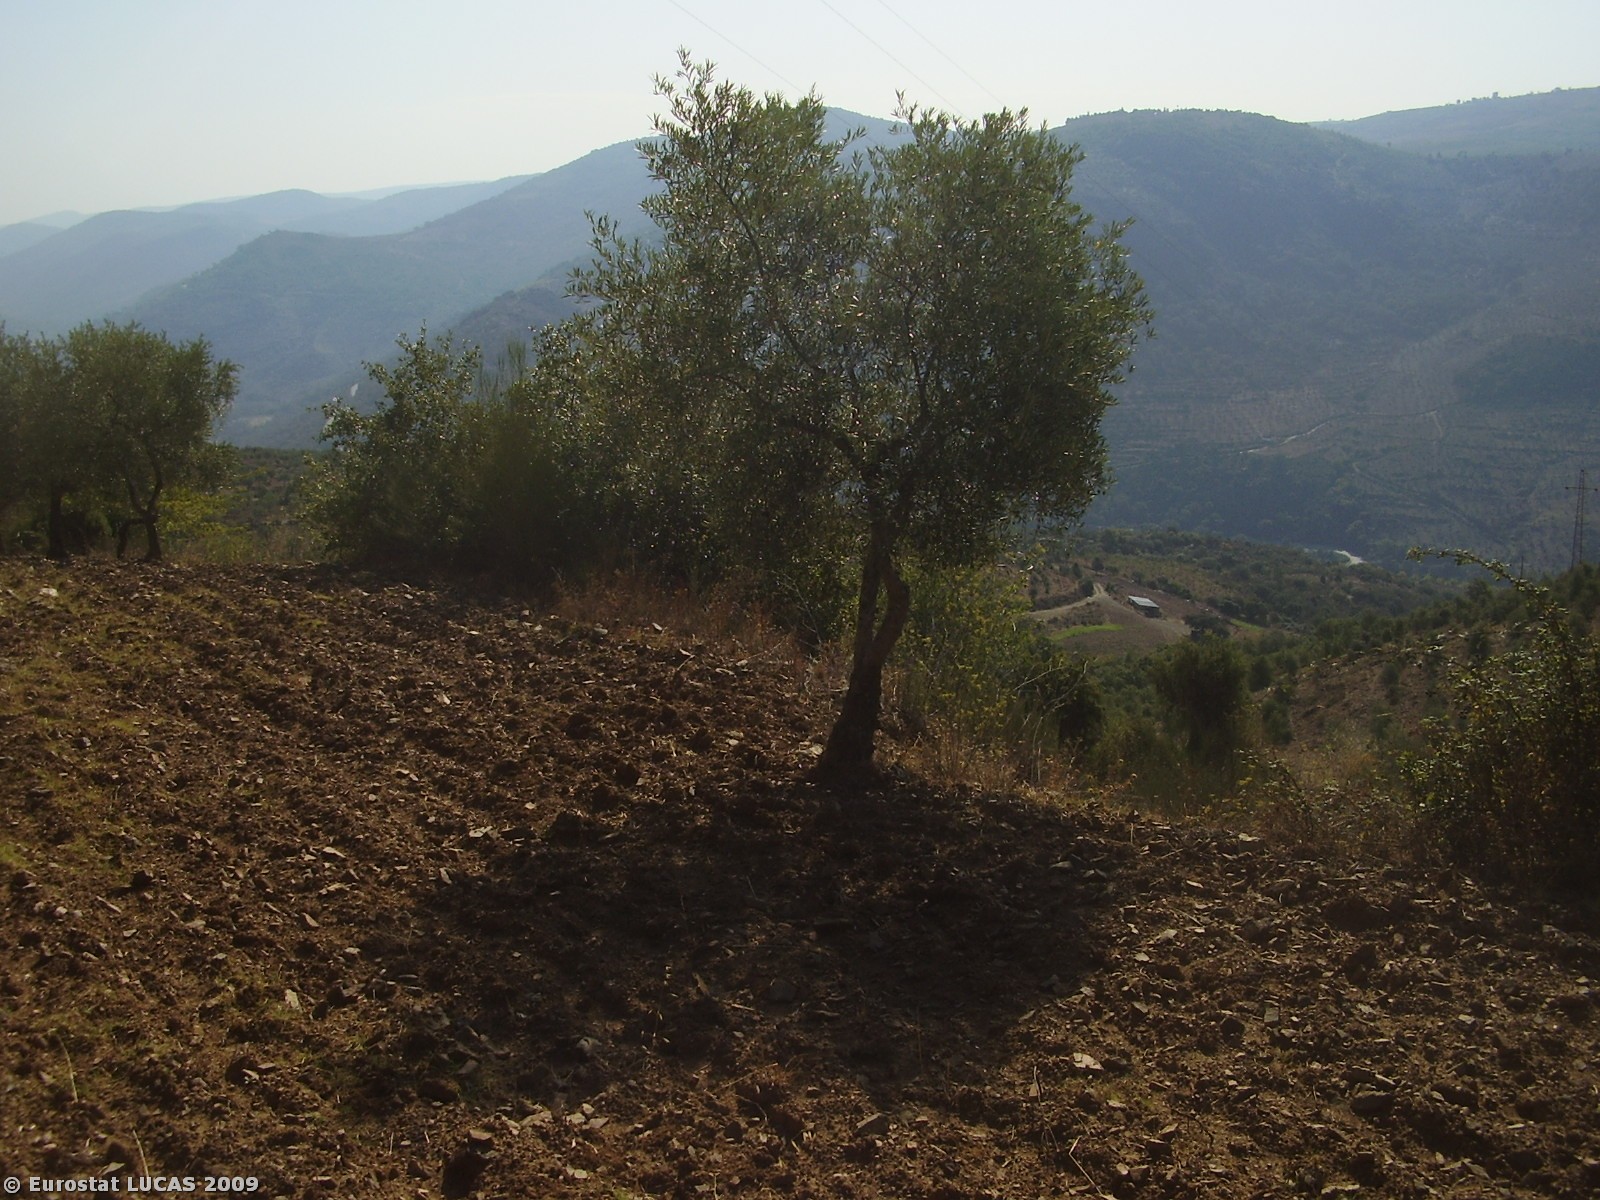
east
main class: Cropland
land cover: Olive groves
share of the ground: 10 - 25 %
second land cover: Bare land
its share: > 75 %
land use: Agriculture (excluding fallow land and kitchen gardens)
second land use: Fallow land
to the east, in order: Olive groves; Bare land; Olive groves; Grass margins; Tracks; Shrubland with sparse tree cover; Broadleaved woodland; Lines of trees; Broadleaved woodland
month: August
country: PT
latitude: 41.4014
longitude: -6.8187
